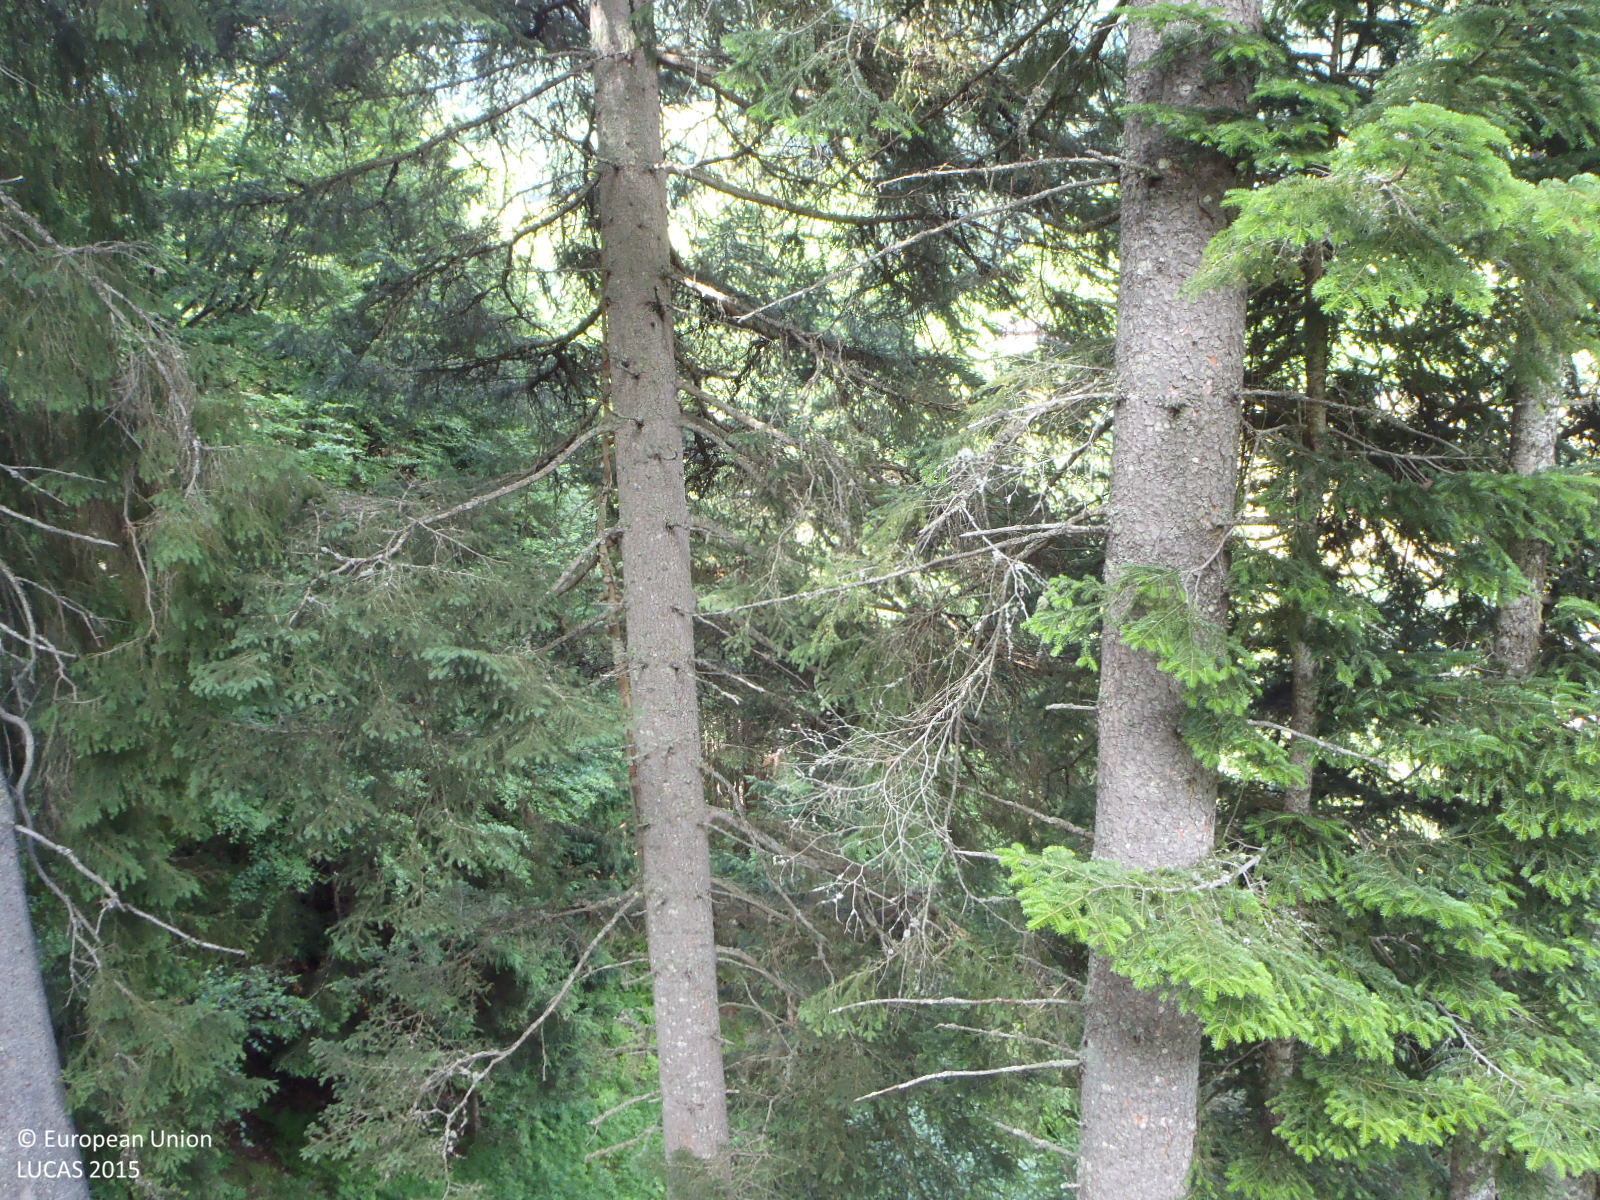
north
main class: Woodland
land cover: Spruce dominated coniferous woodland
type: alpine coniferous forest
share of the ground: 50 - 75 %
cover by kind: coniferous forest trees 60 %, broadleaved forest trees 10 %, shrubs 10 %, herbaceous plants 10 %, lichens and mosses 10 %
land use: Forestry
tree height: > 5 m
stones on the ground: < 10 %
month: June
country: AT
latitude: 47.3811
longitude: 12.6605
